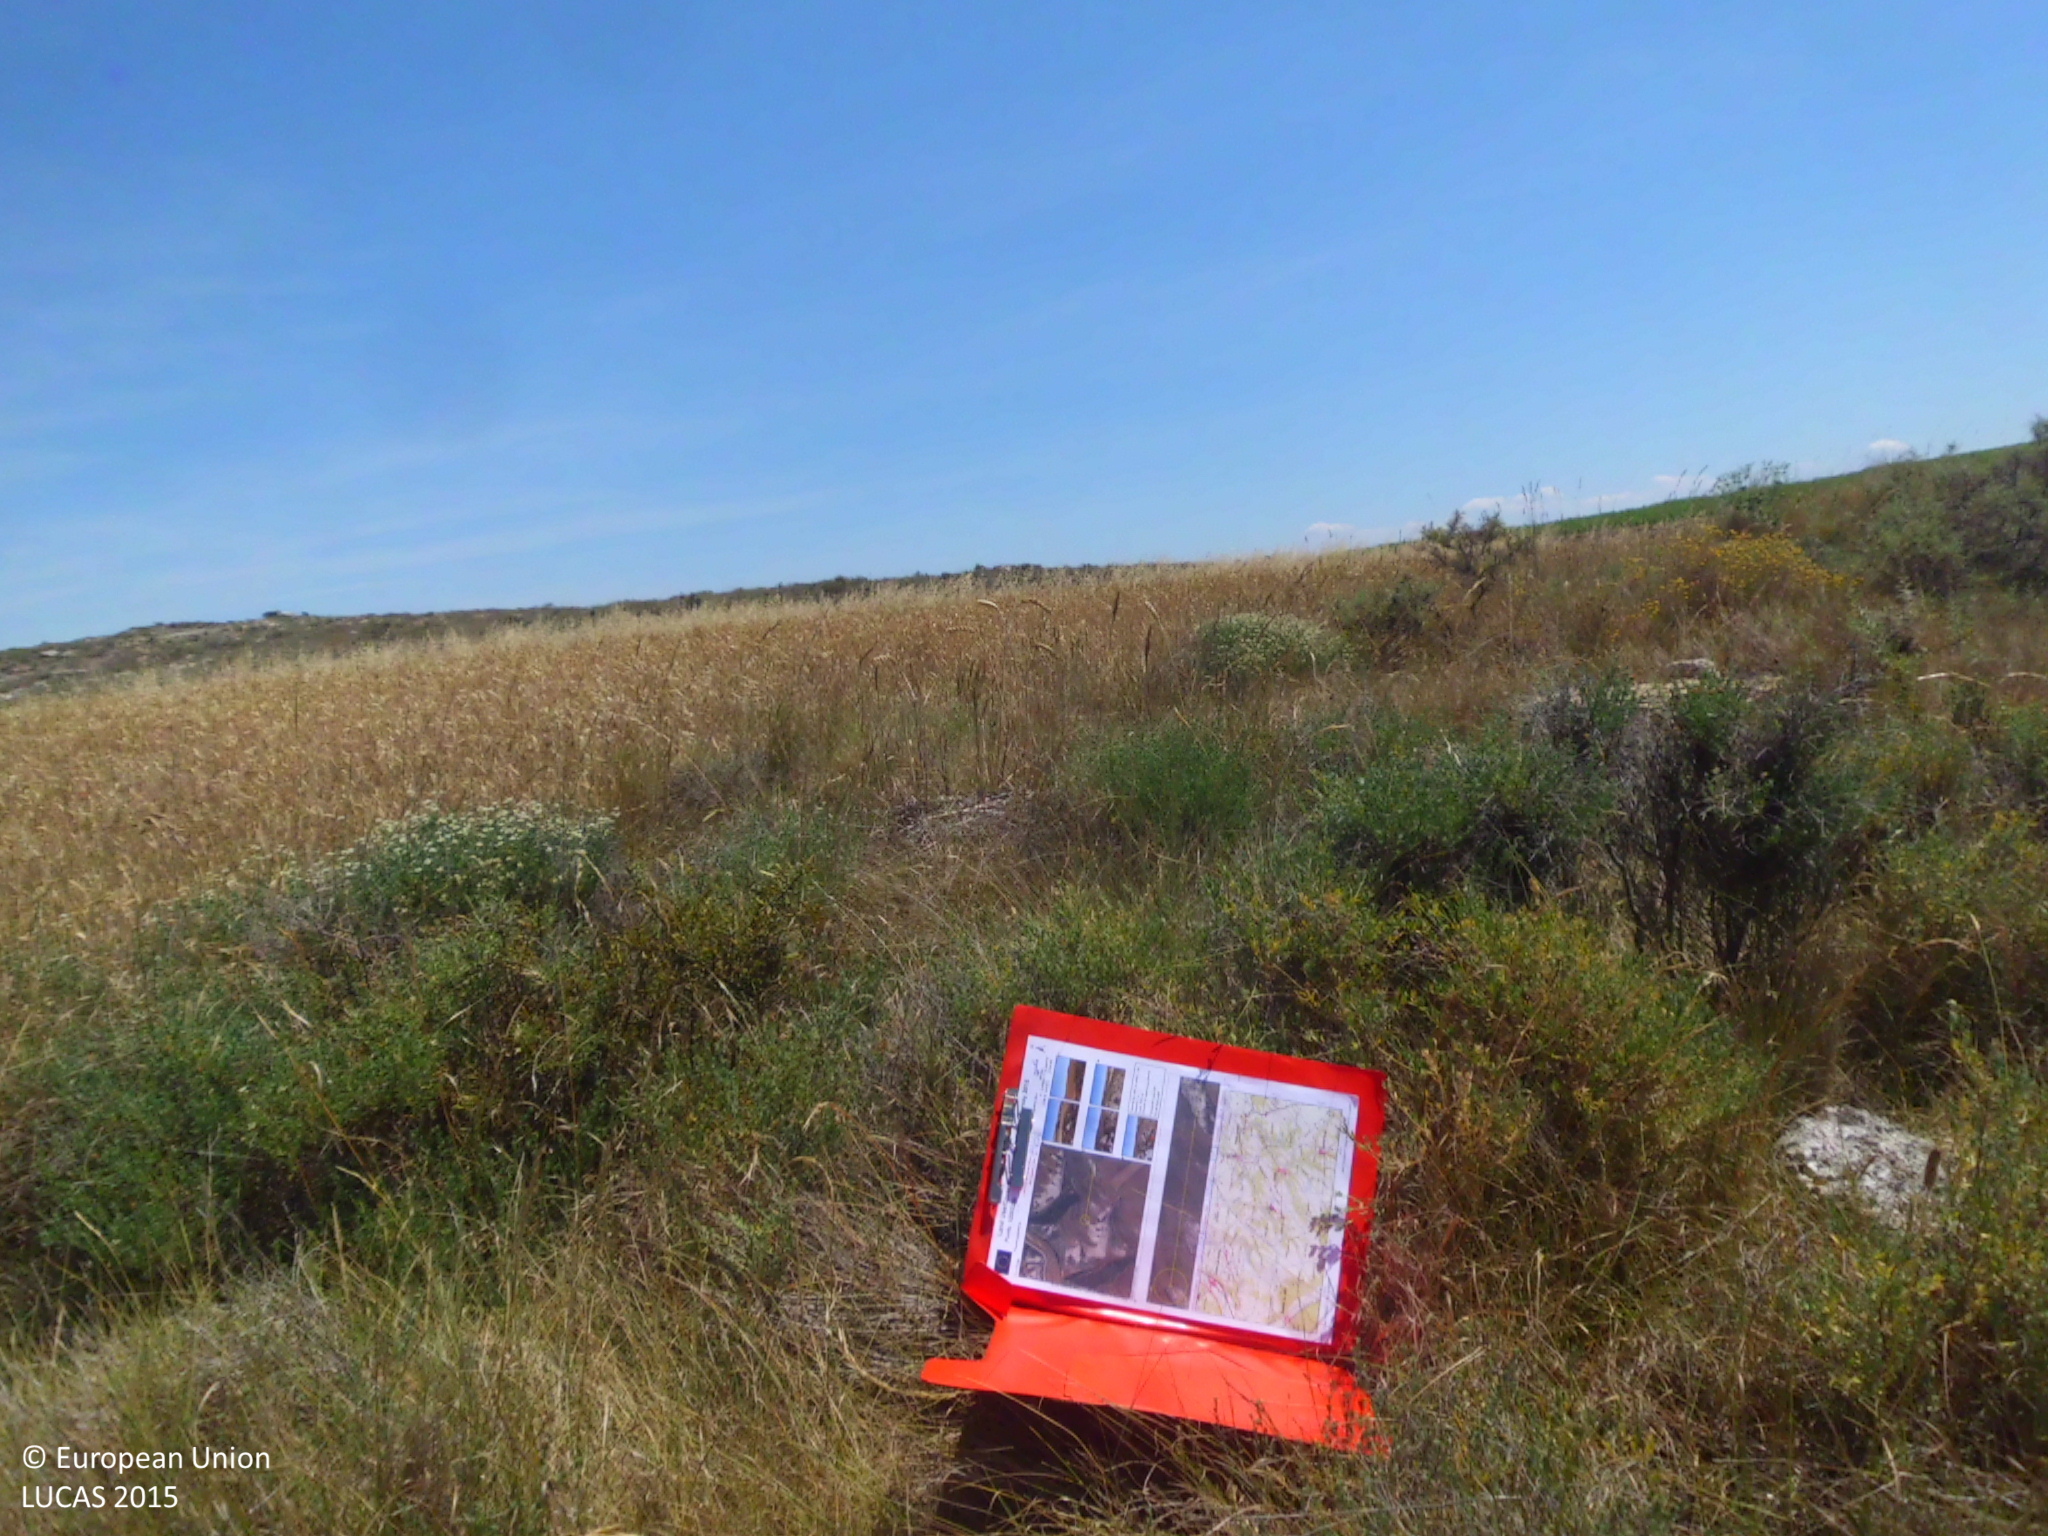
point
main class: Shrubland
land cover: Shrubland without tree cover
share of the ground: 50 - 75 %
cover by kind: shrubs 50 %, unconsolidated bare surface 35 %, herbaceous plants 15 %
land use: Semi-natural and natural areas not in use
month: July
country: ES
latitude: 42.4848
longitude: -3.3045
